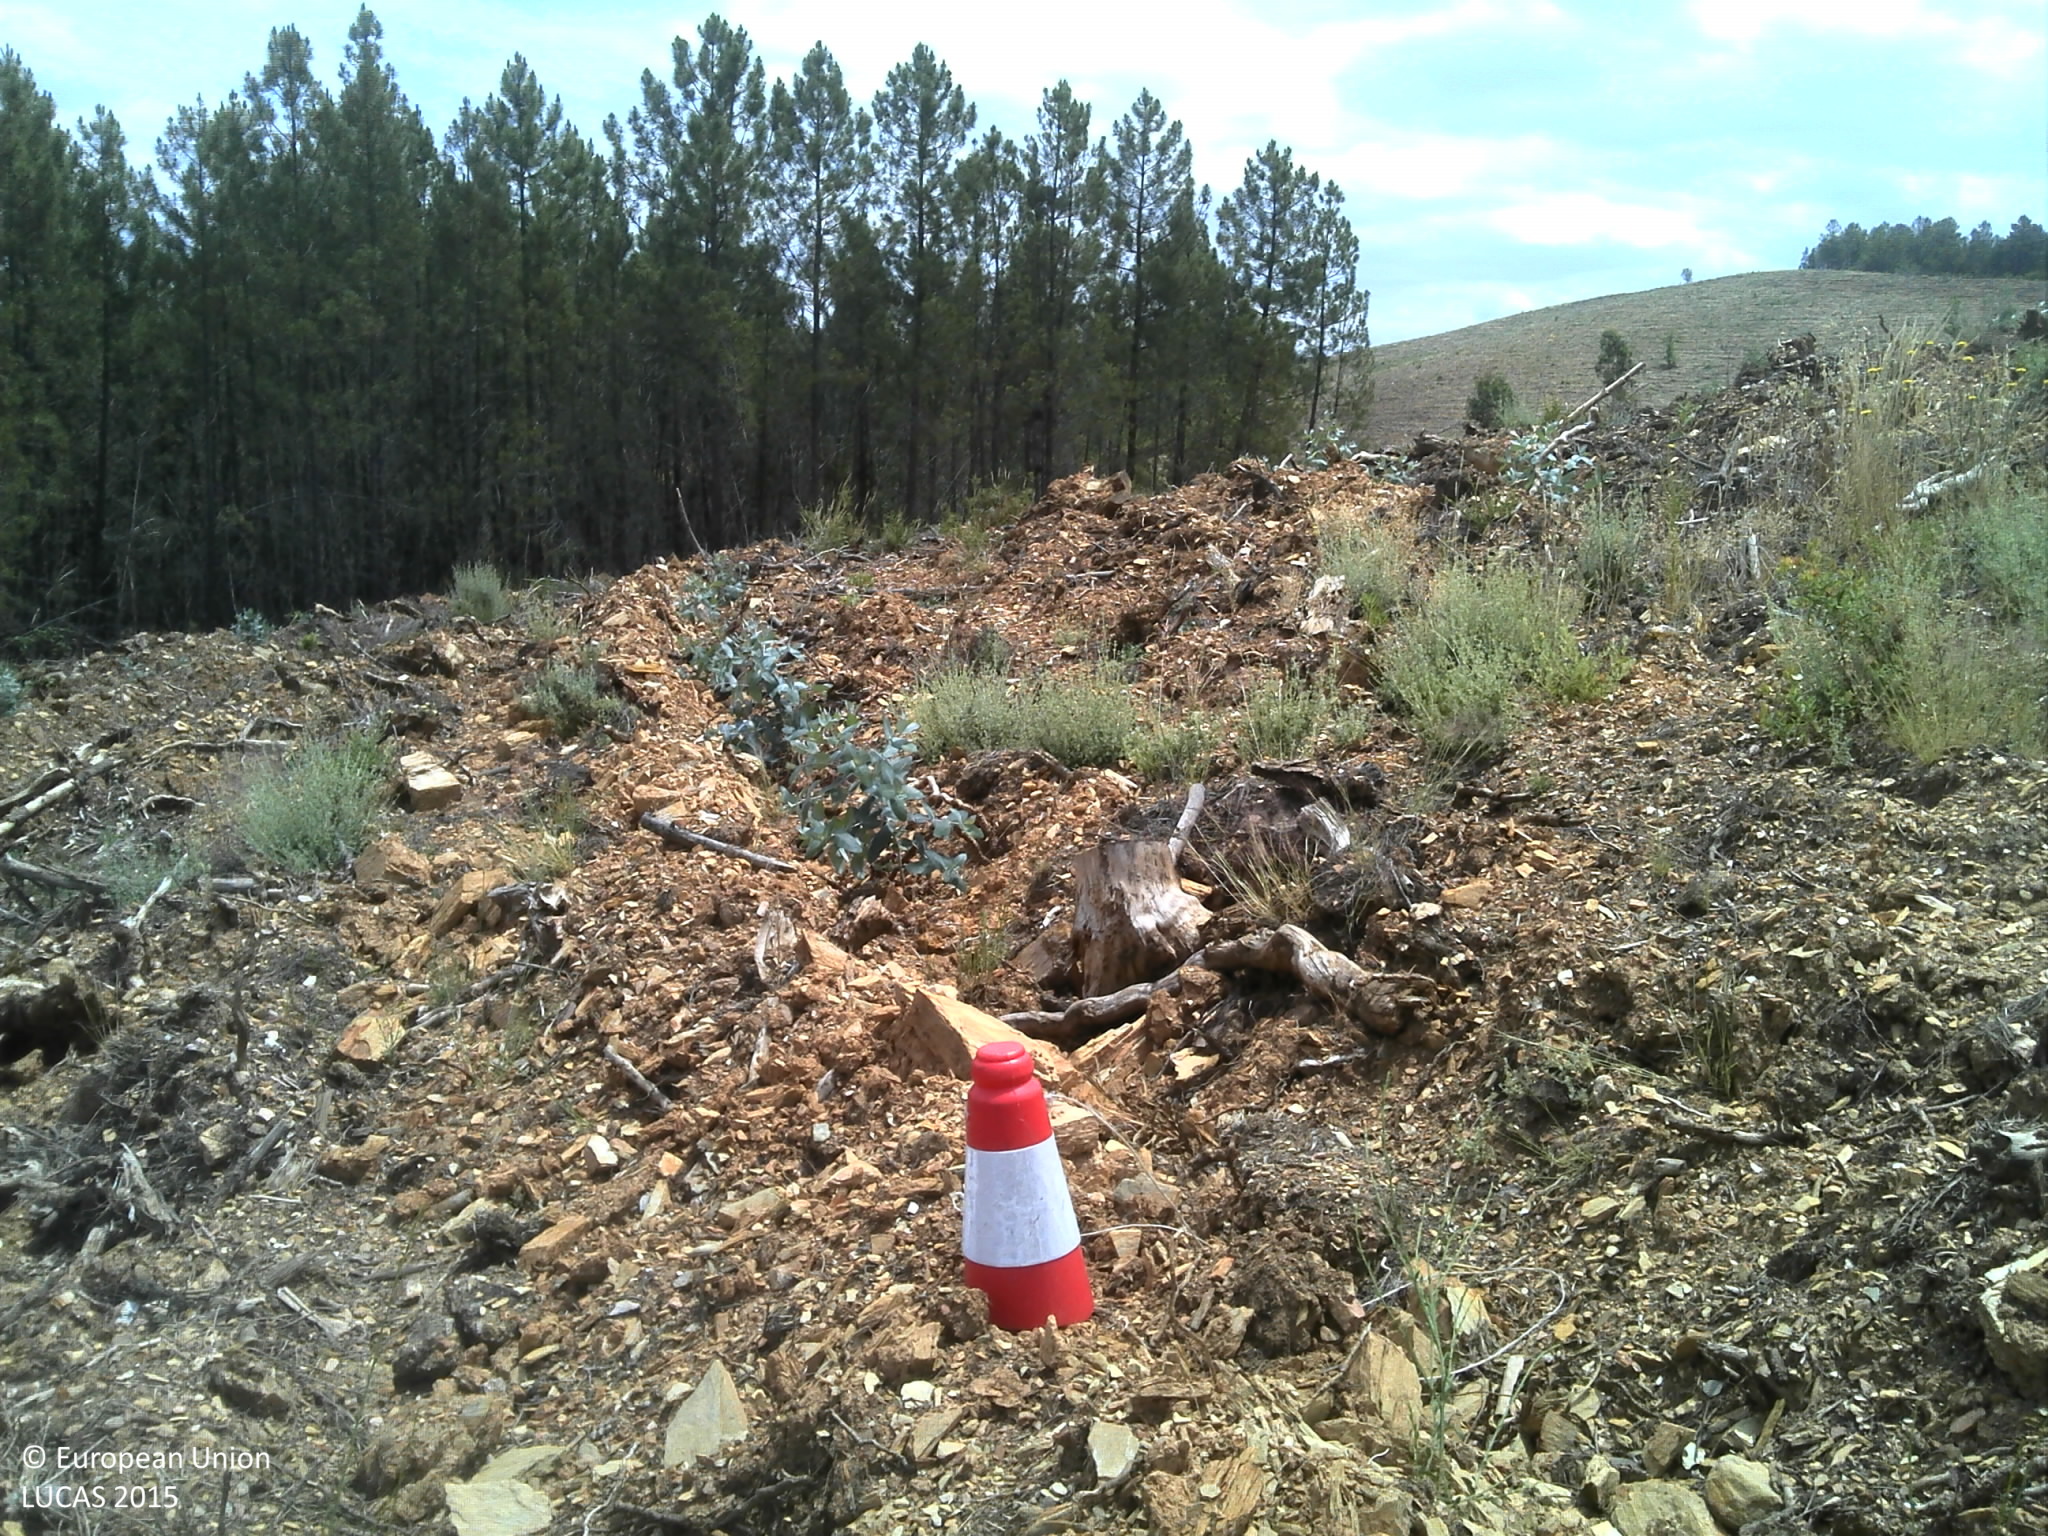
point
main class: Woodland
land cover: Broadleaved woodland
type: exotic forest
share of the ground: < 10 %
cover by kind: unconsolidated bare surface 85 %, broadleaved forest trees 10 %, herbaceous plants 5 %
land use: Forestry
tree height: < 5 m
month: June
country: PT
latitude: 40.1617
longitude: -7.3731
